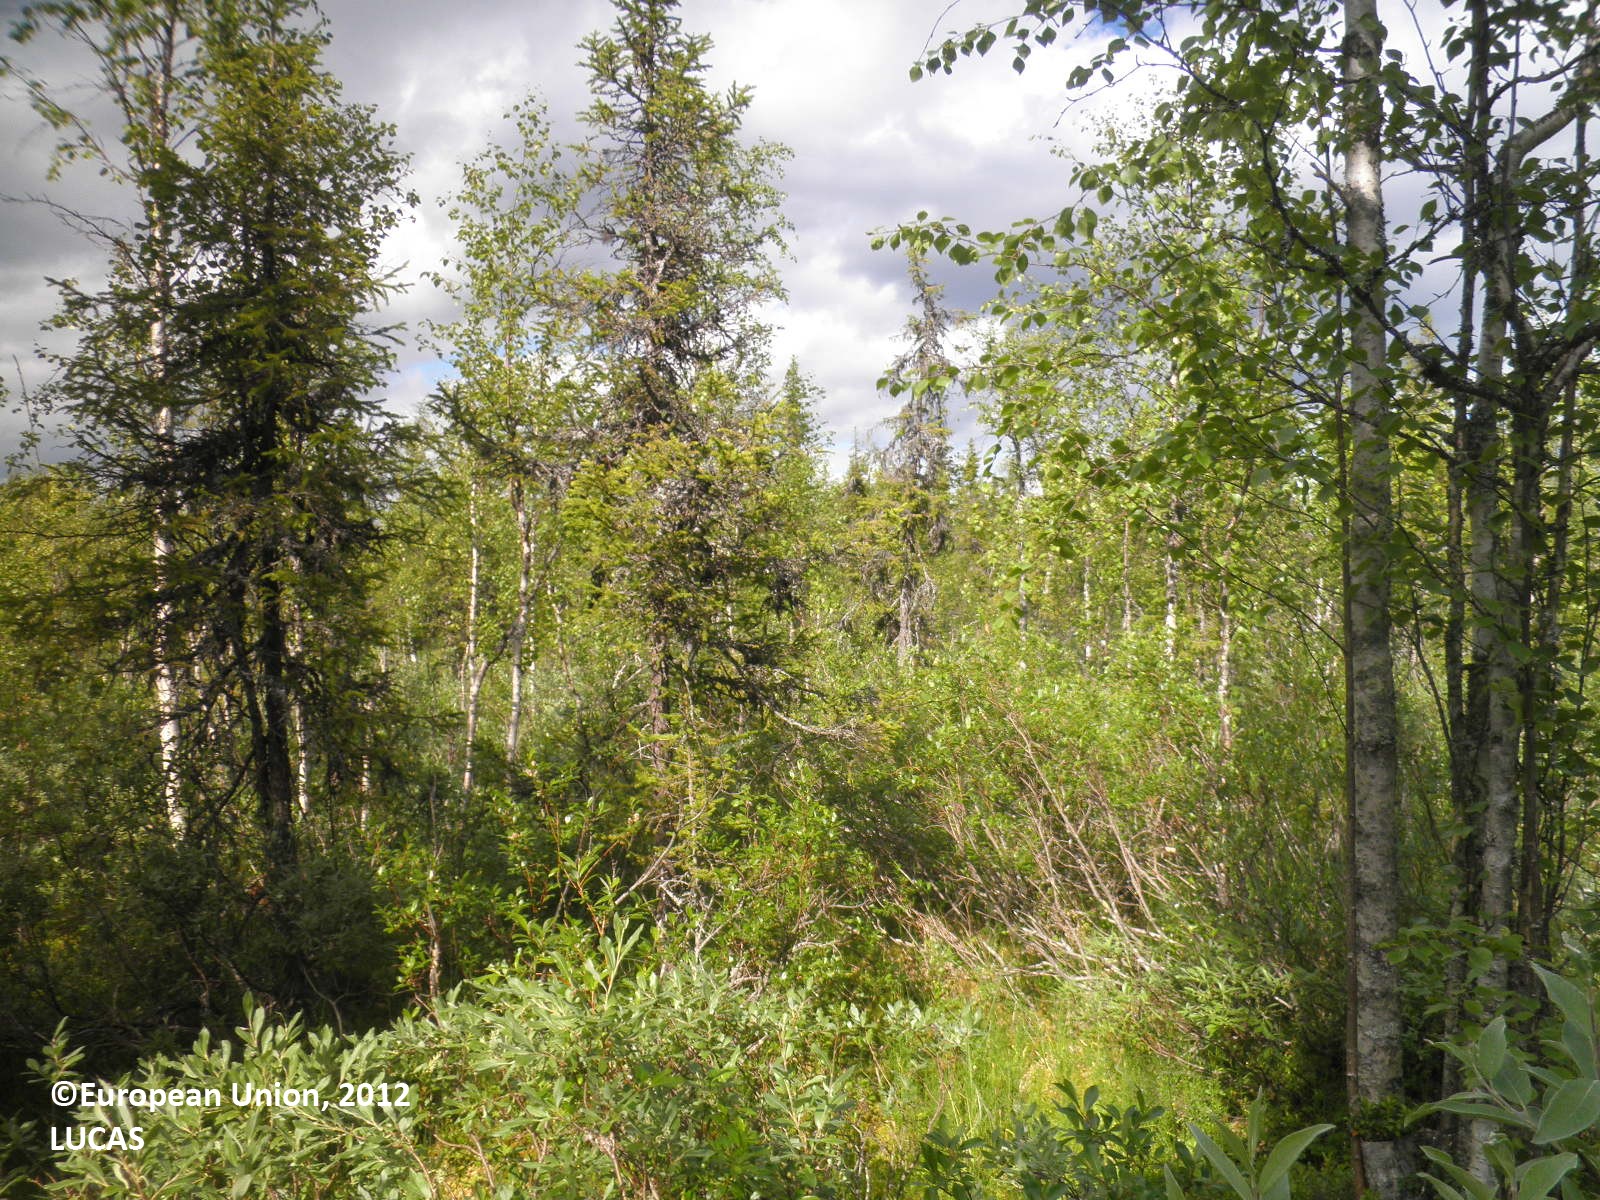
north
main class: Woodland
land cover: Spruce dominated mixed woodland
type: boreal forest
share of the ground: 50 - 75 %
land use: Forestry
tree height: > 5 m
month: July
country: FI
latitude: 67.6191
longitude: 25.8460
